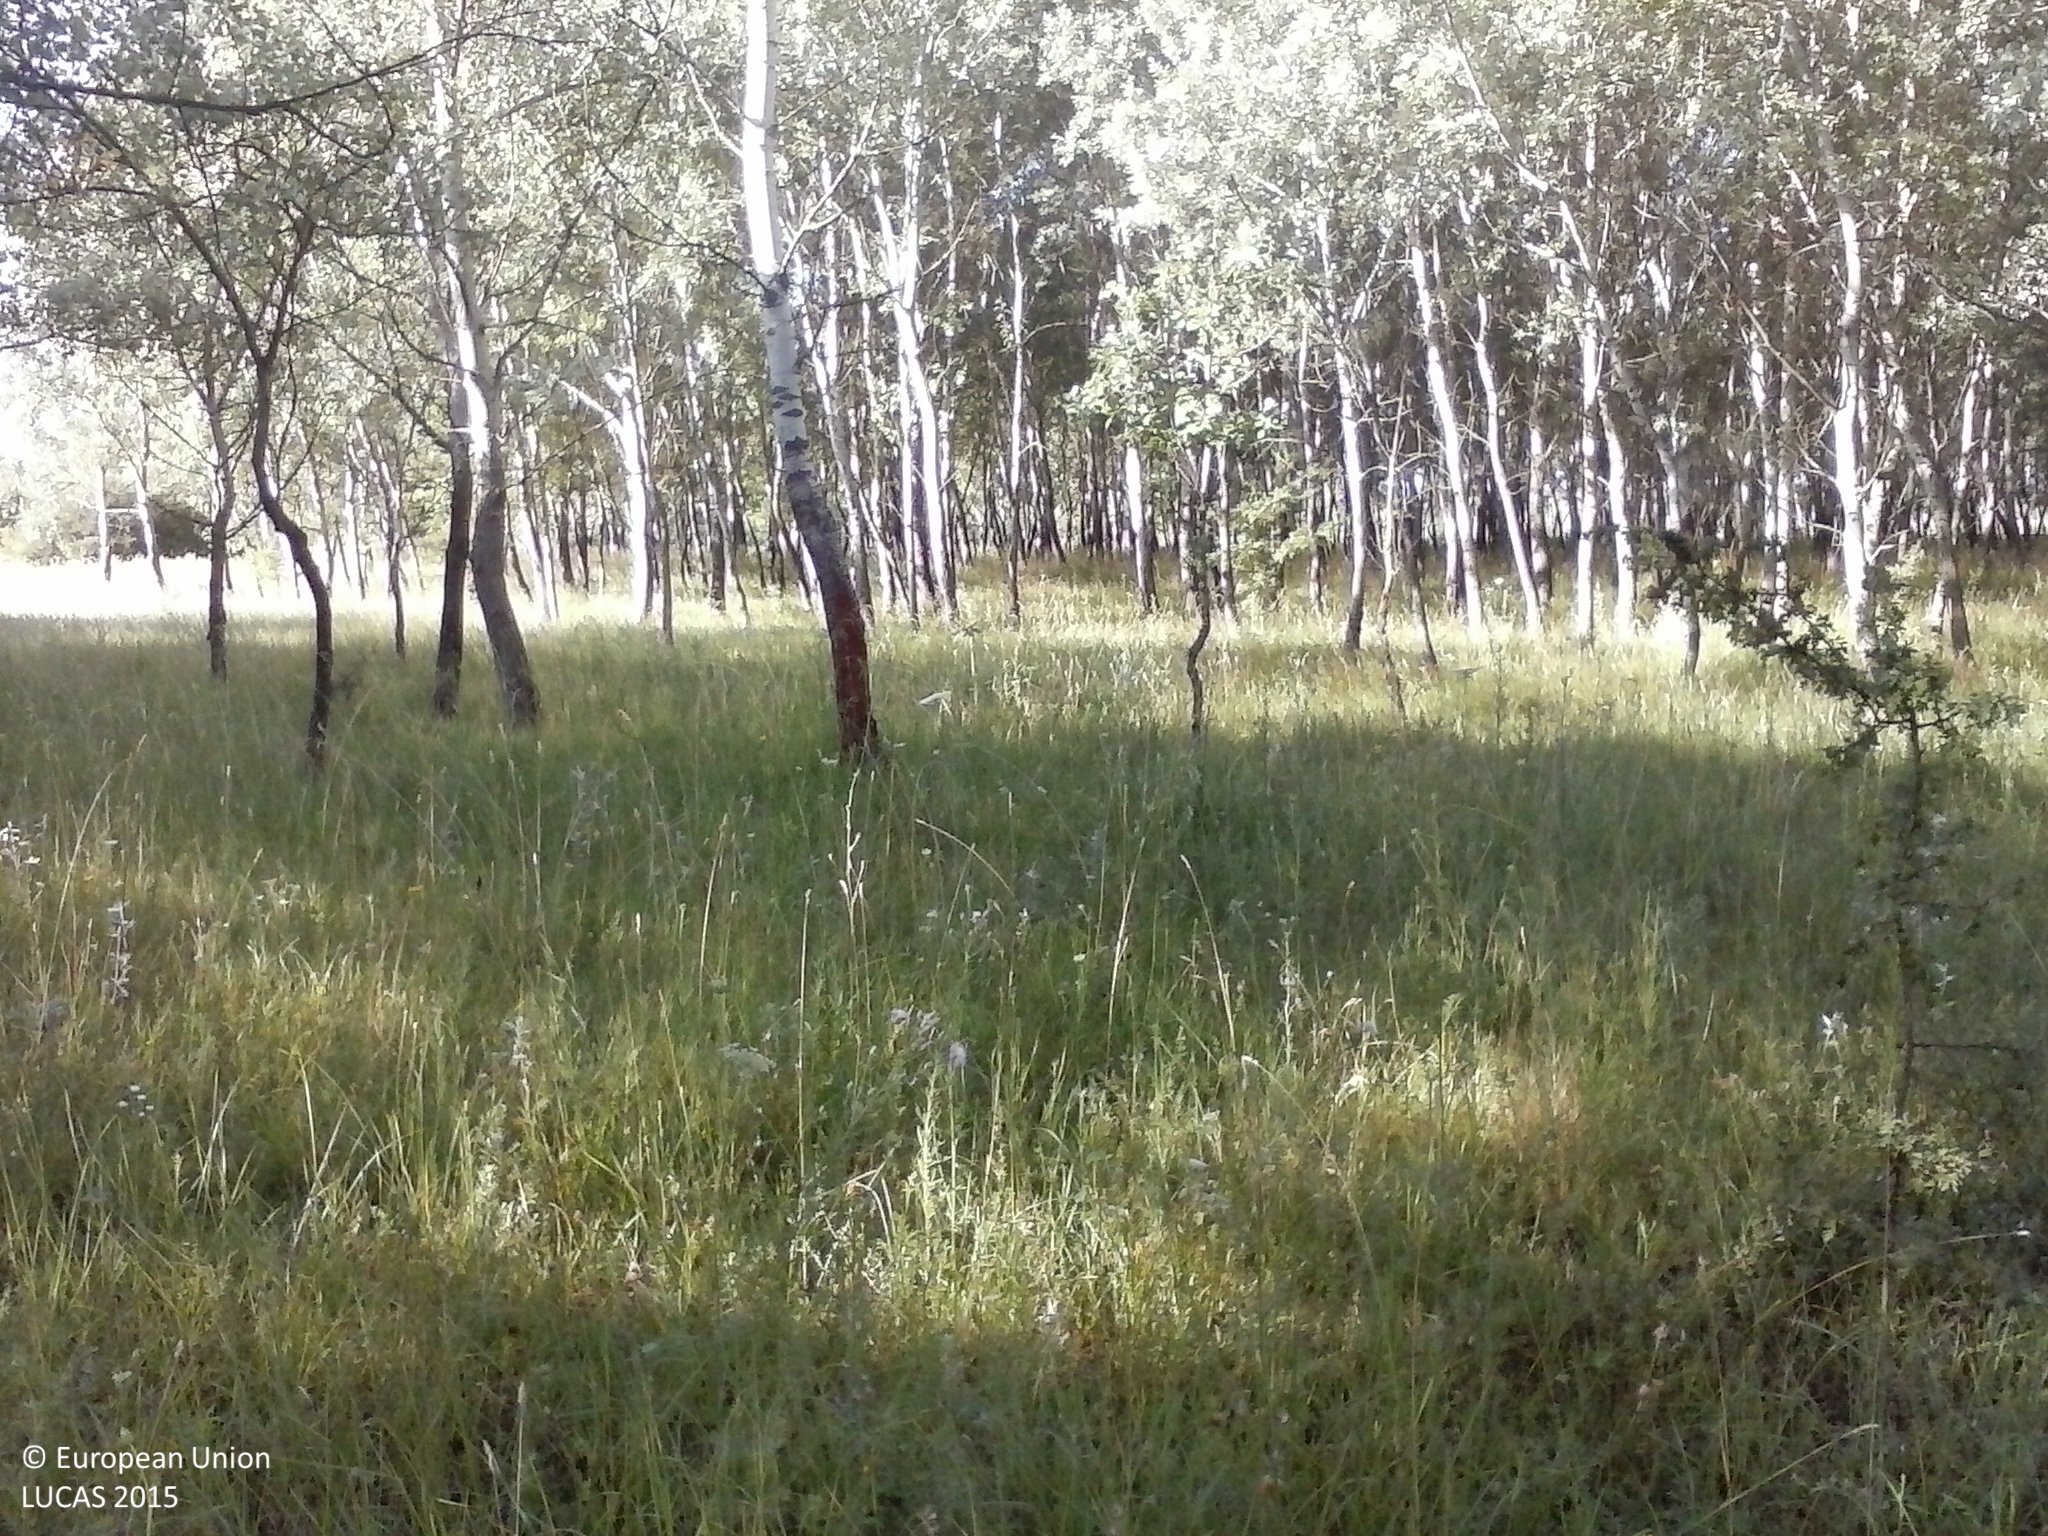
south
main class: Woodland
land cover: Broadleaved woodland
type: non-riverine alder, birch or aspen forest
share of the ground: > 75 %
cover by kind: broadleaved forest trees 80 %, herbaceous plants 15 %, shrubs 5 %
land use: Forestry
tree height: > 5 m
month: July
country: HU
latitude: 46.3789
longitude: 19.5211
